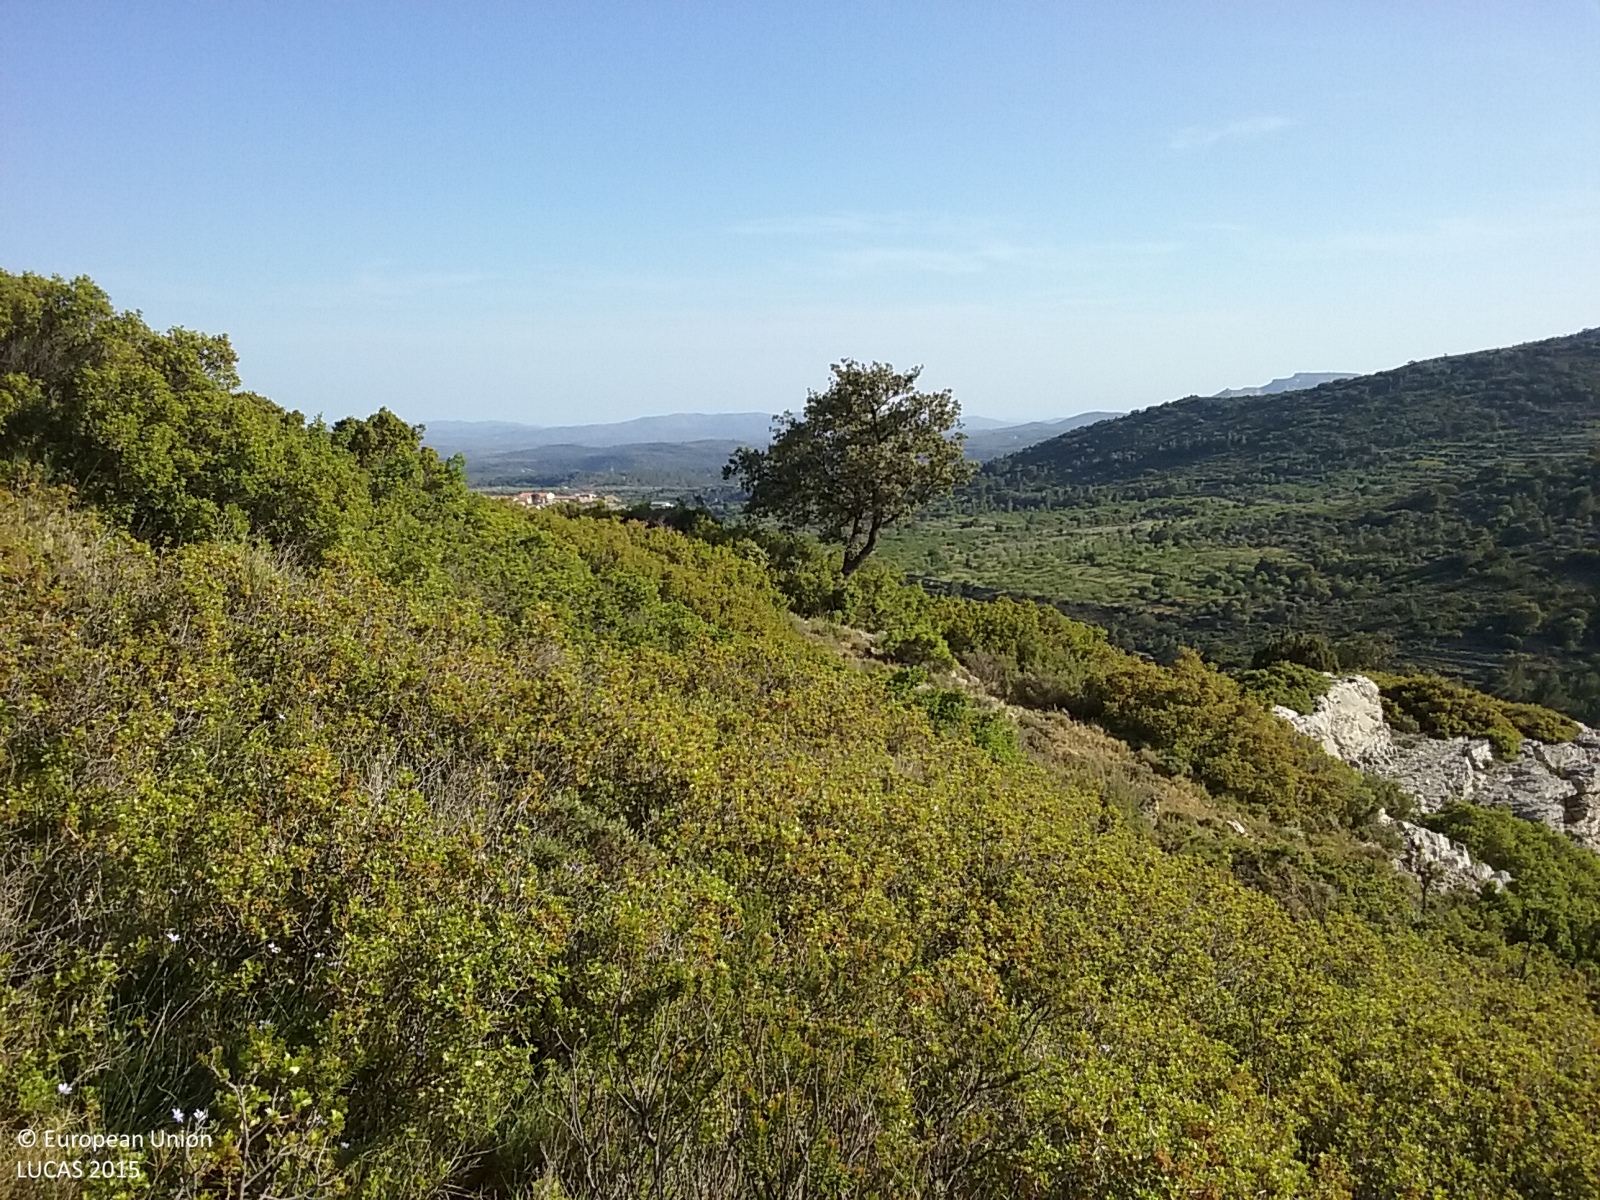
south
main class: Shrubland
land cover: Shrubland without tree cover
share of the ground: > 75 %
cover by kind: shrubs 95 %
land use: Semi-natural and natural areas not in use
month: May
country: ES
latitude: 40.6330
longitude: 0.2163
